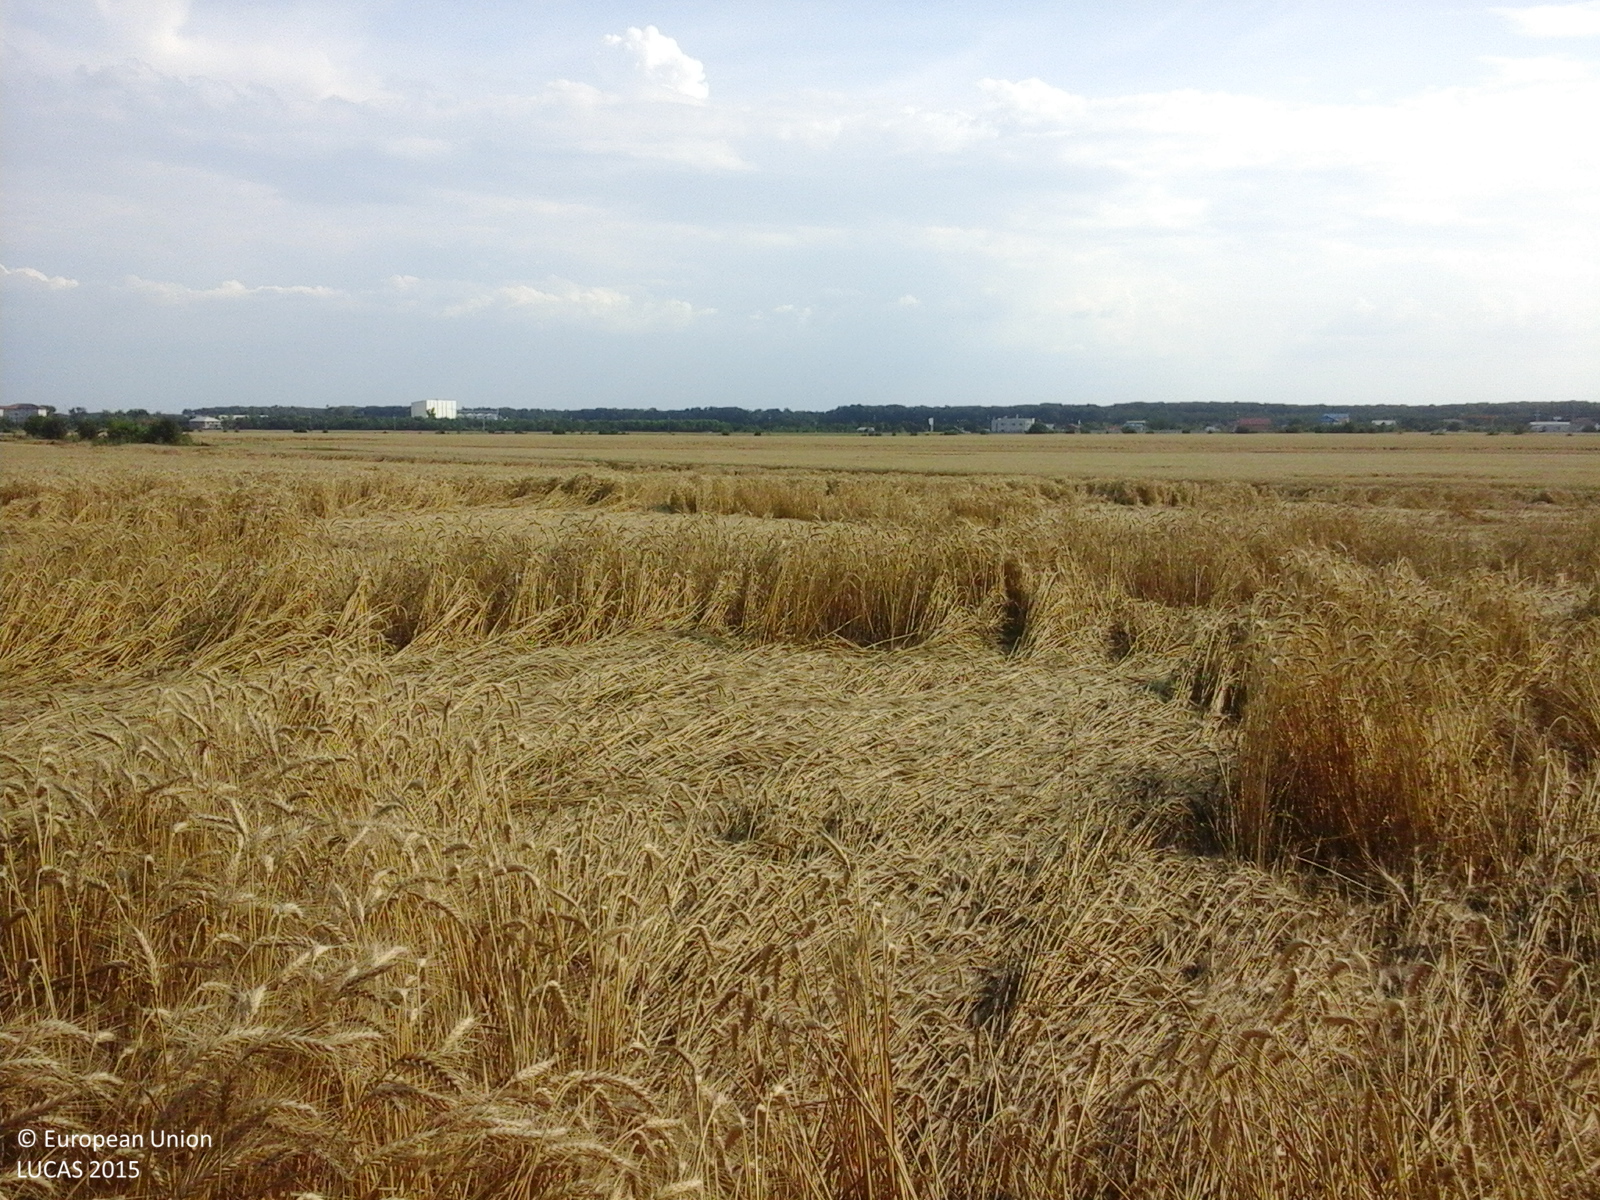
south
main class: Cropland
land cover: Common wheat
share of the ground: > 75 %
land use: Agriculture (excluding fallow land and kitchen gardens)
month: June
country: RO
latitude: 44.5394
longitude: 25.9475
